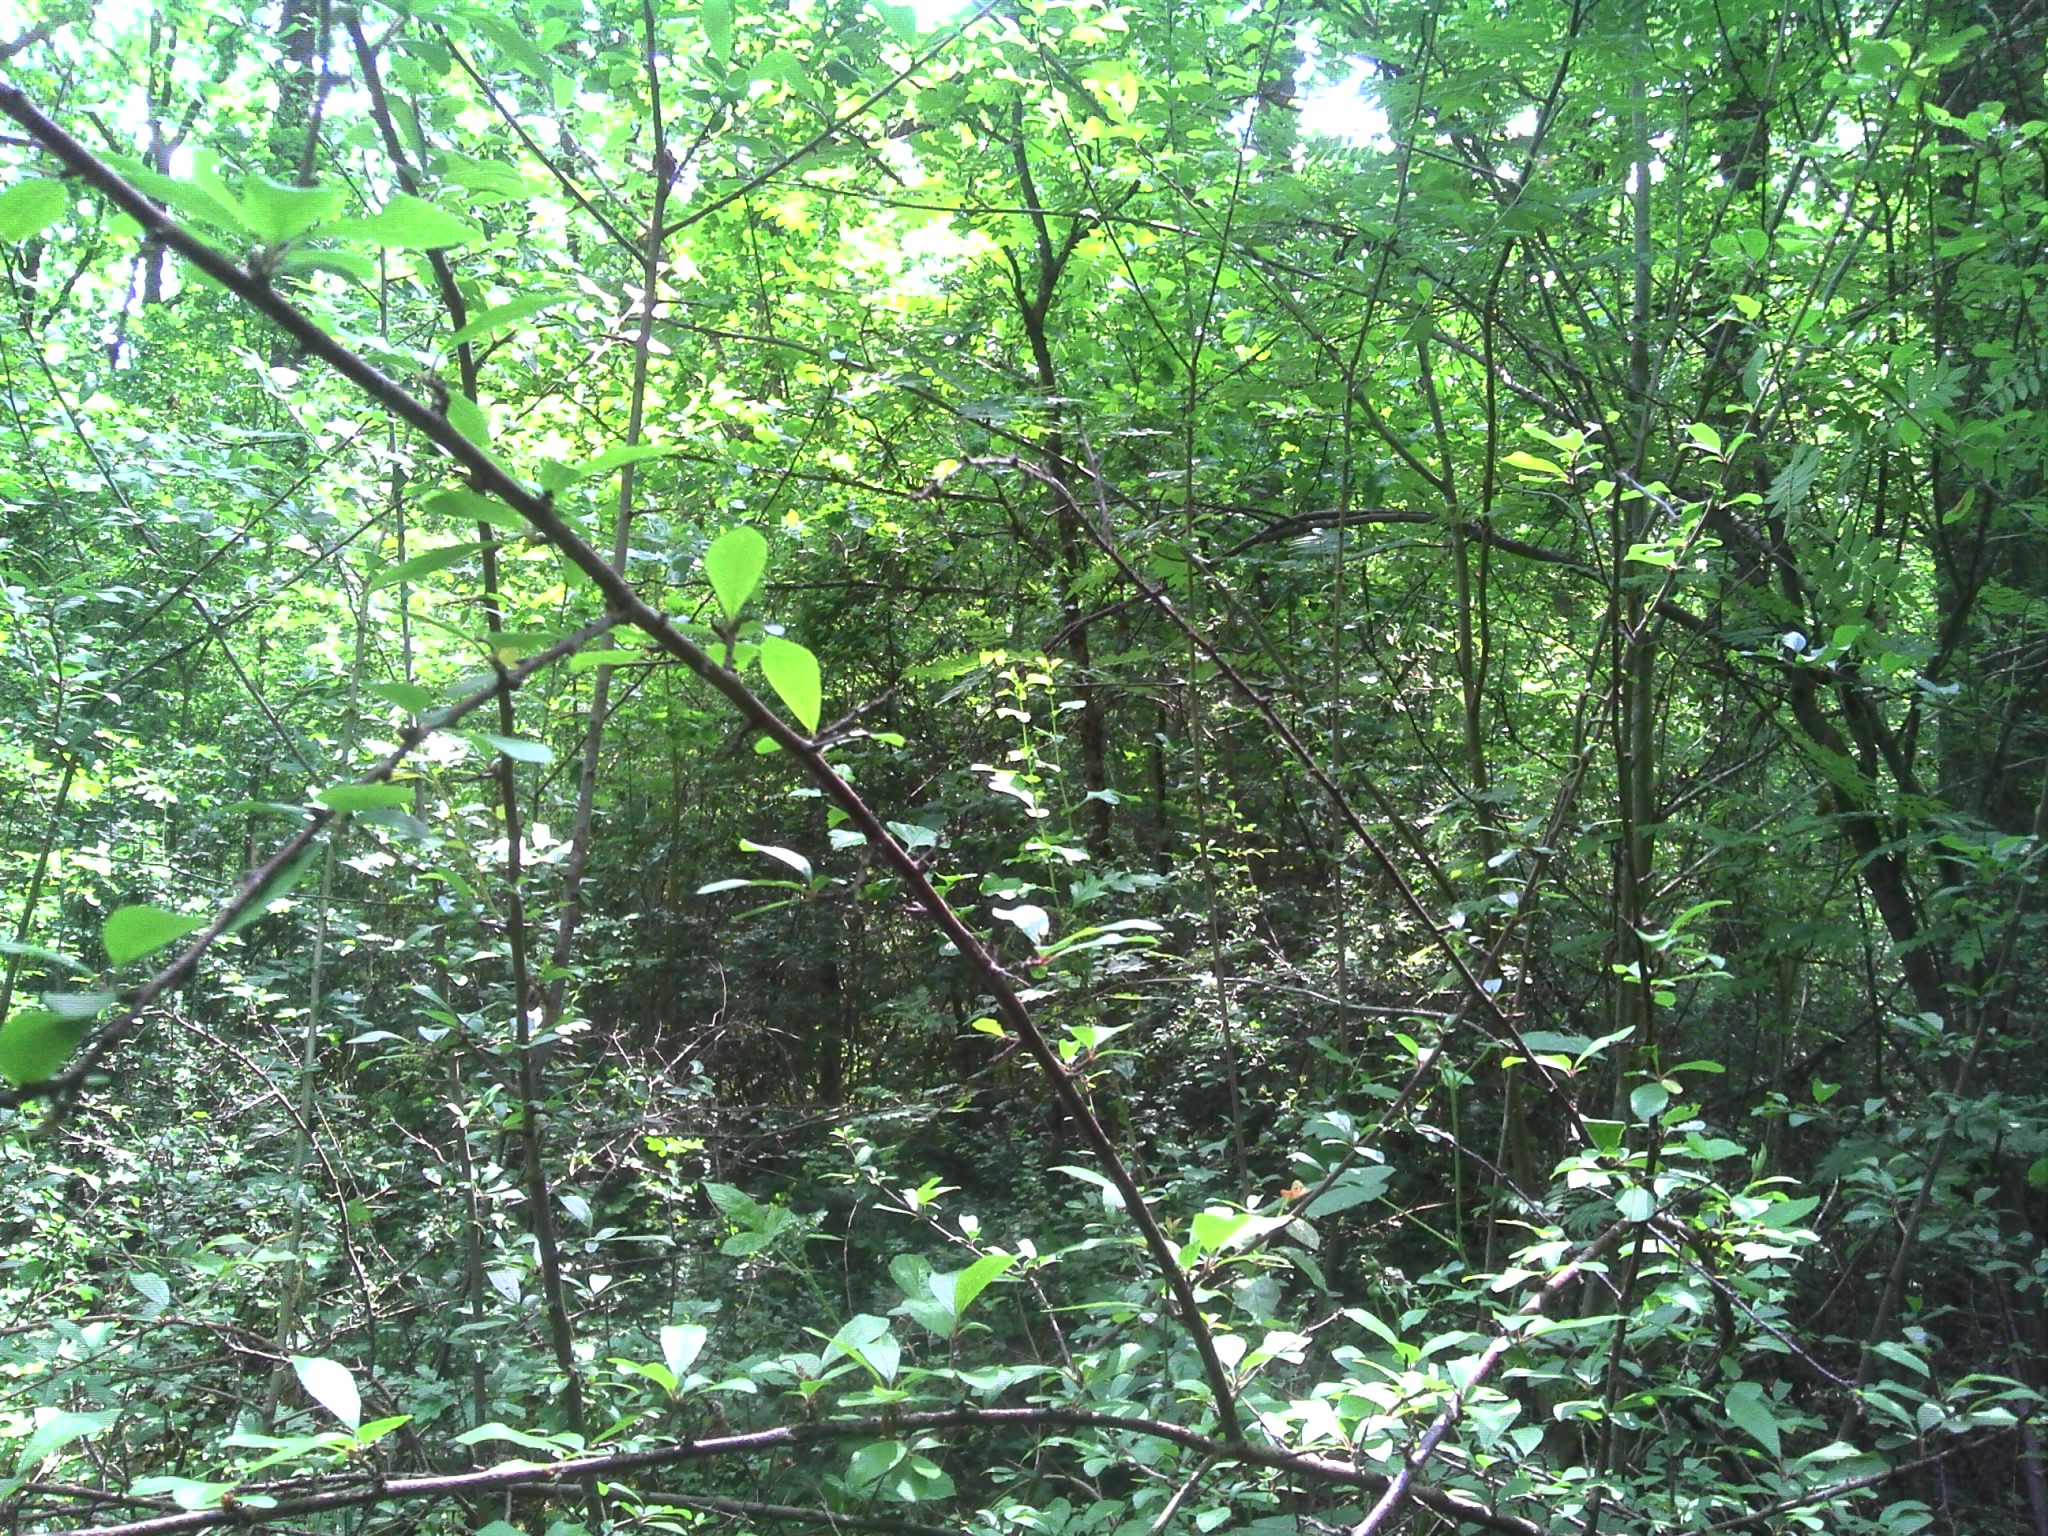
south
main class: Woodland
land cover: Broadleaved woodland
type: mesophytic deciduous forest
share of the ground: > 75 %
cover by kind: broadleaved forest trees 85 %, shrubs 10 %, herbaceous plants 5 %
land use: Forestry
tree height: > 5 m
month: June
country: BE
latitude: 50.2281
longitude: 5.2177
